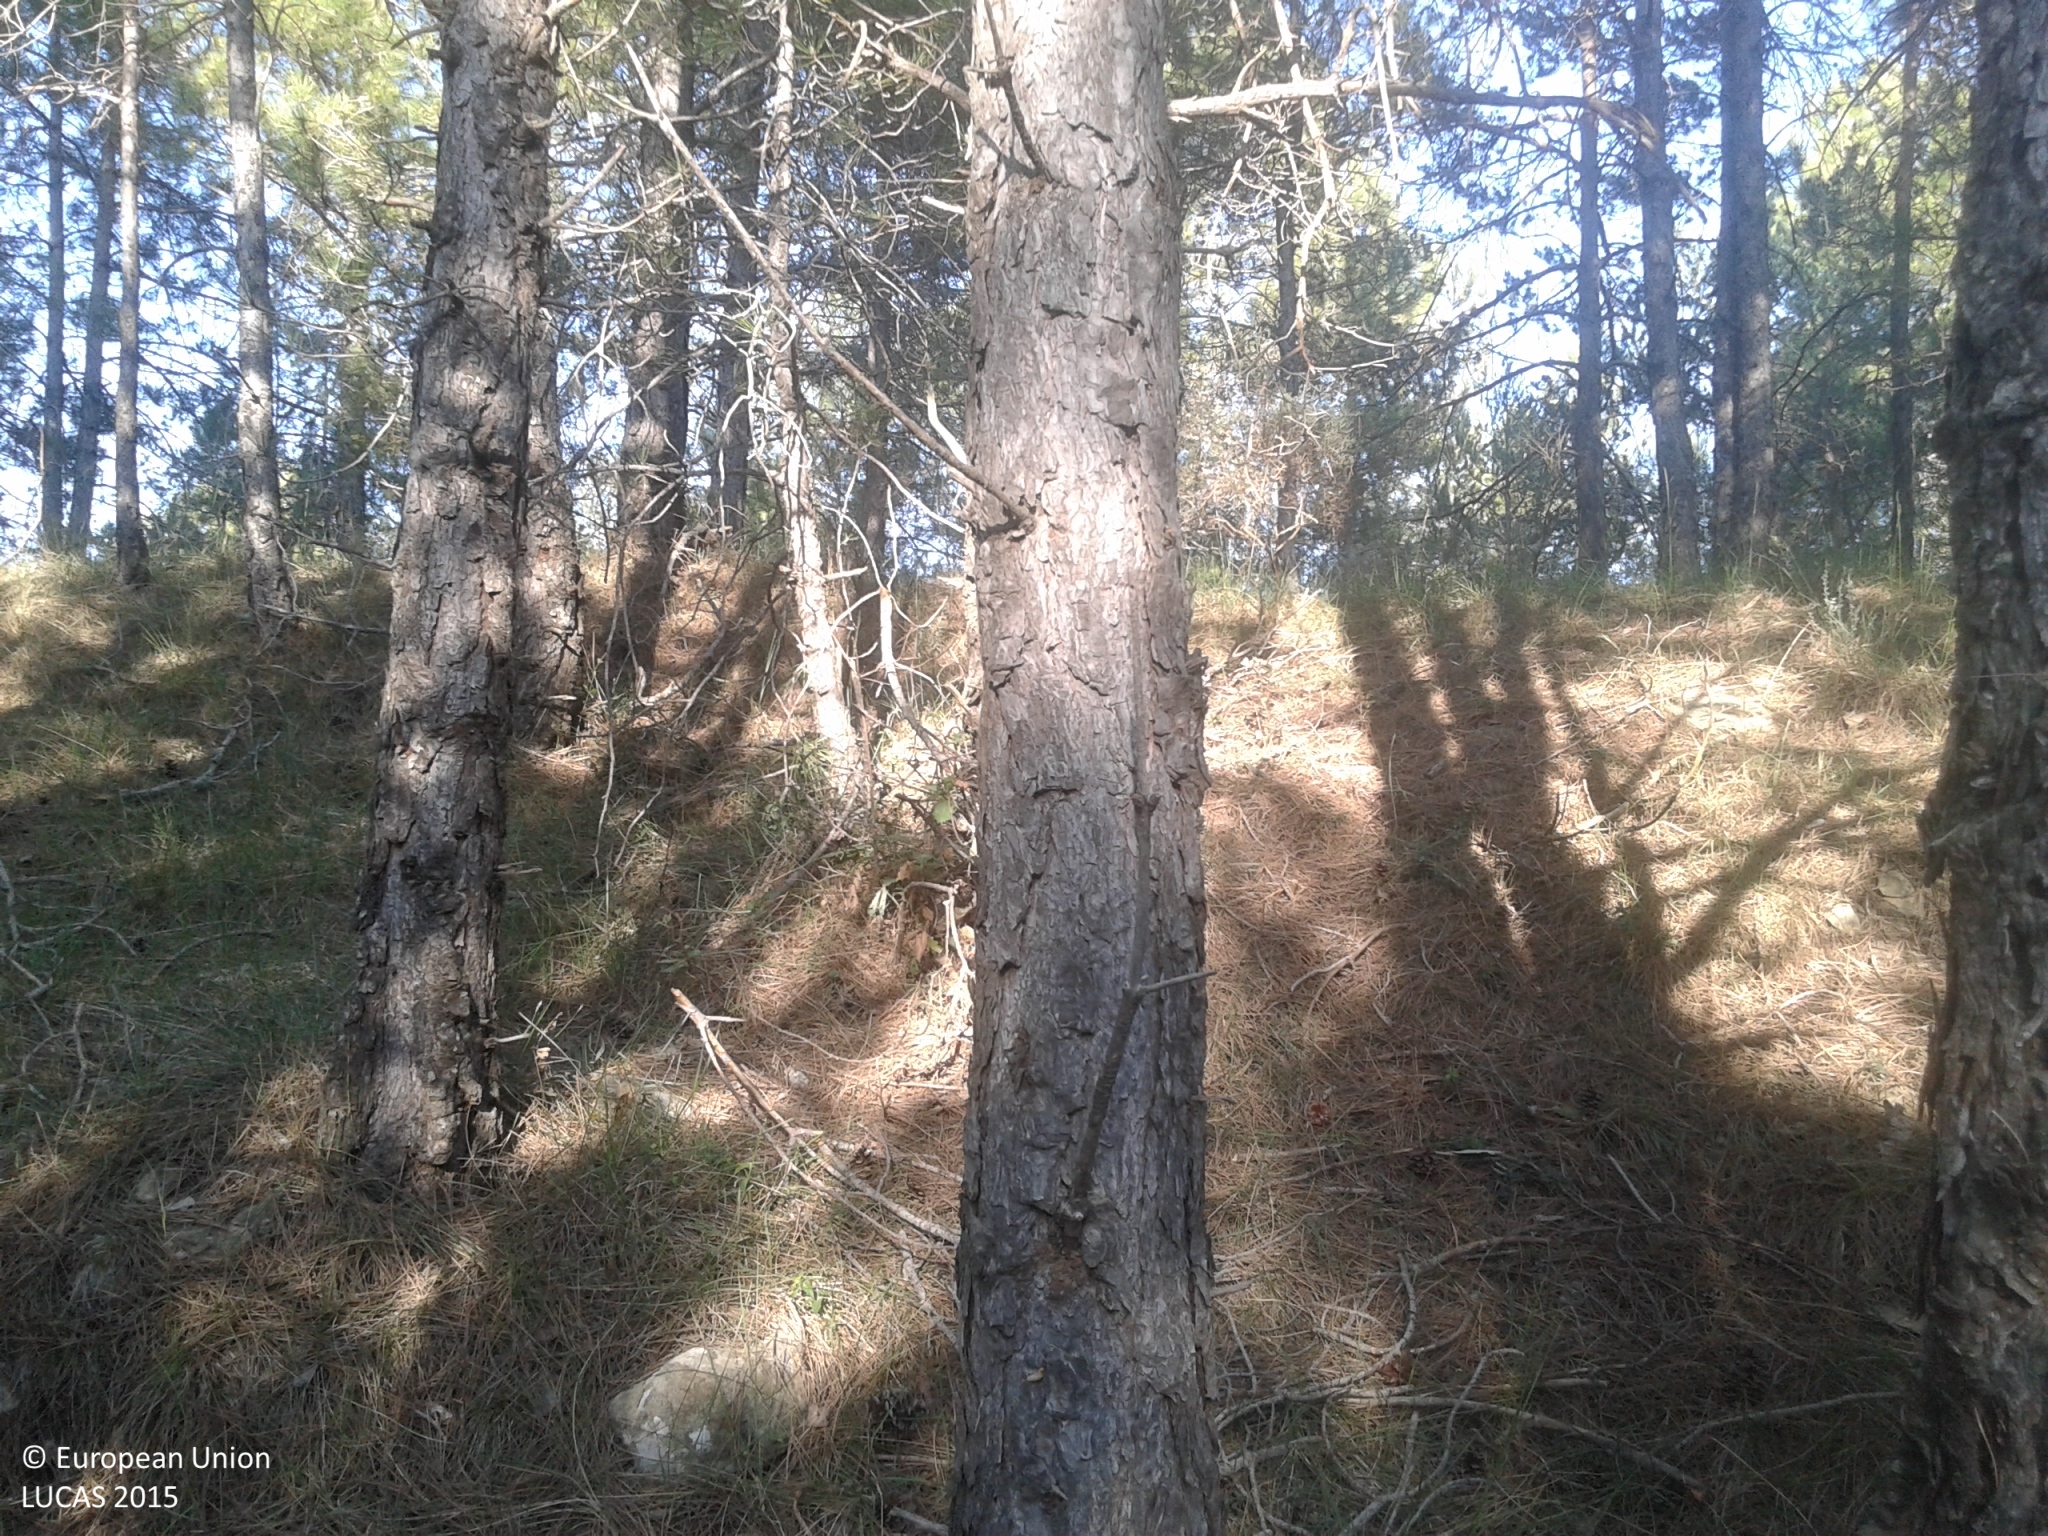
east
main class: Woodland
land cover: Pine dominated coniferous woodland
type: coniferous forest of the mediterranean region
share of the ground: > 75 %
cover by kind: coniferous forest trees 95 %, shrubs 5 %
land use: Semi-natural and natural areas not in use
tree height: > 5 m
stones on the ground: 10 - 25 %
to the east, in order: Pine dominated coniferous woodland; Tracks; Pine dominated coniferous woodland; Pine dominated mixed woodland; Grassland without tree/shrub cover; Broadleaved woodland
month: May
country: ES
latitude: 42.0538
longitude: 1.6391
